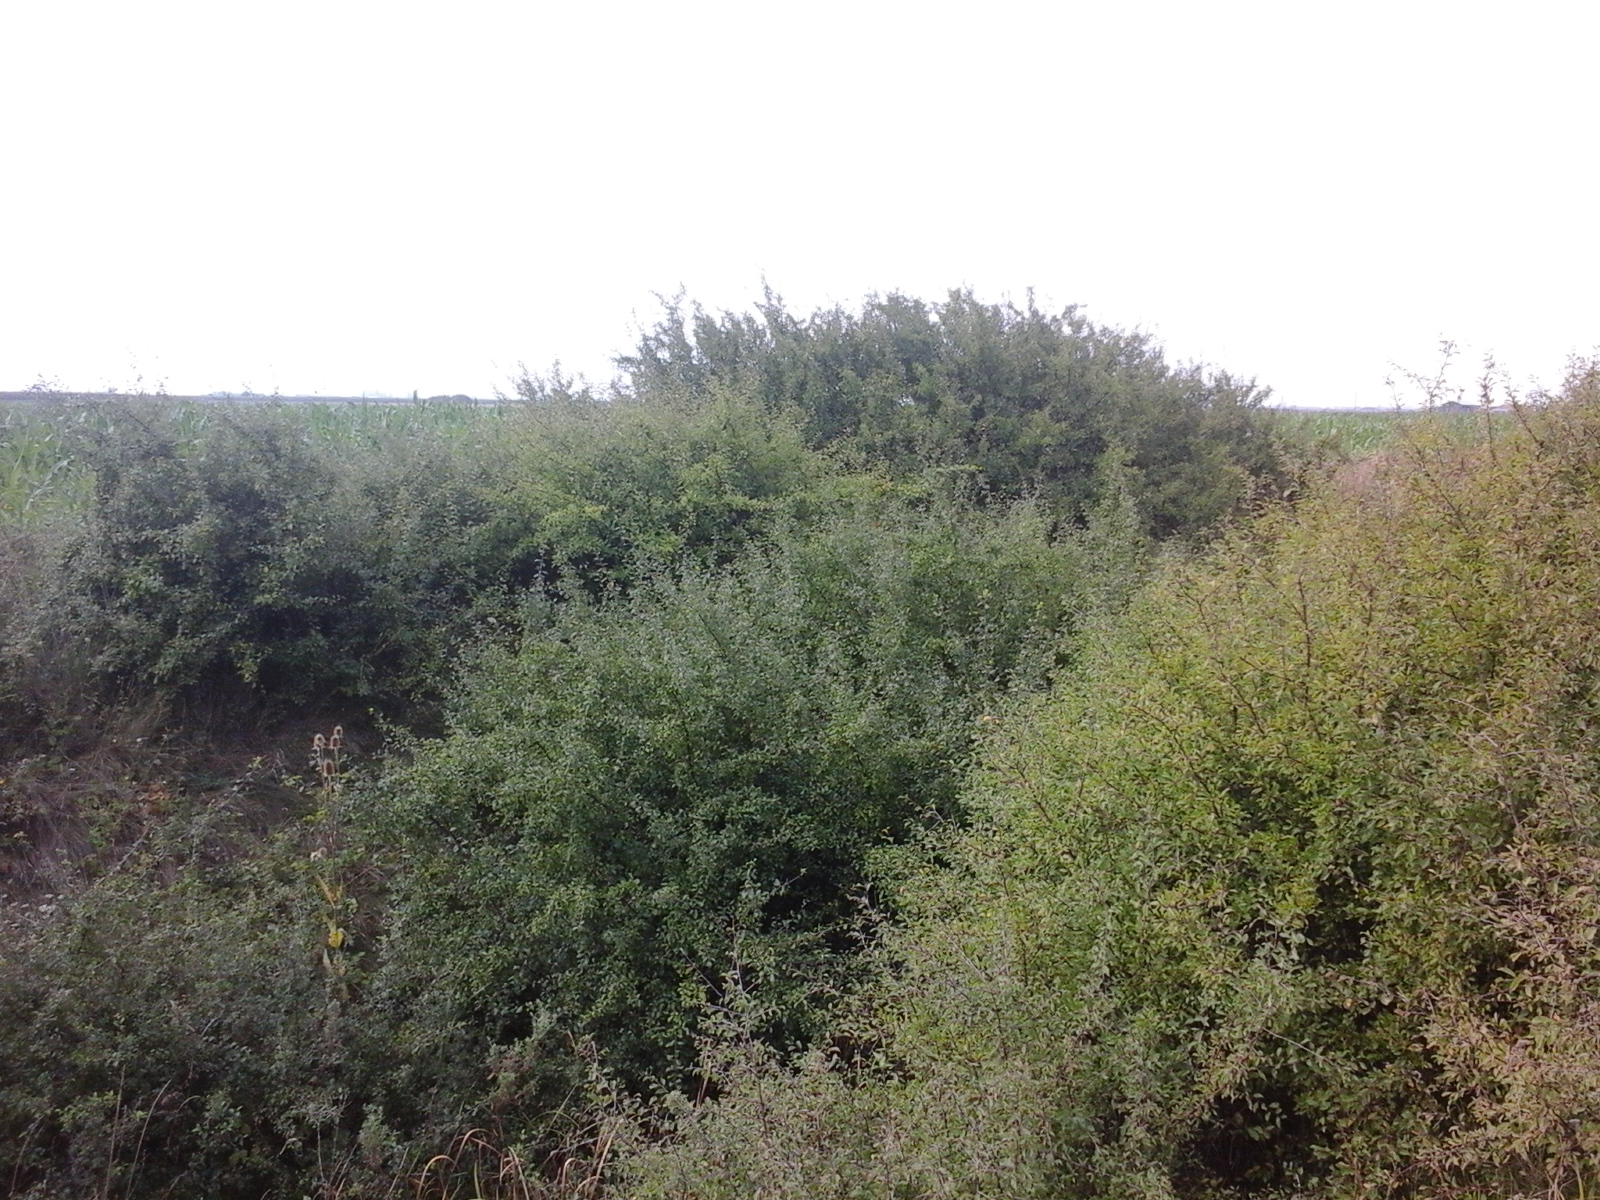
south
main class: Cropland
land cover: Maize
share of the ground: > 75 %
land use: Agriculture (excluding fallow land and kitchen gardens)
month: August
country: RO
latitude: 46.7899
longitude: 21.6079
